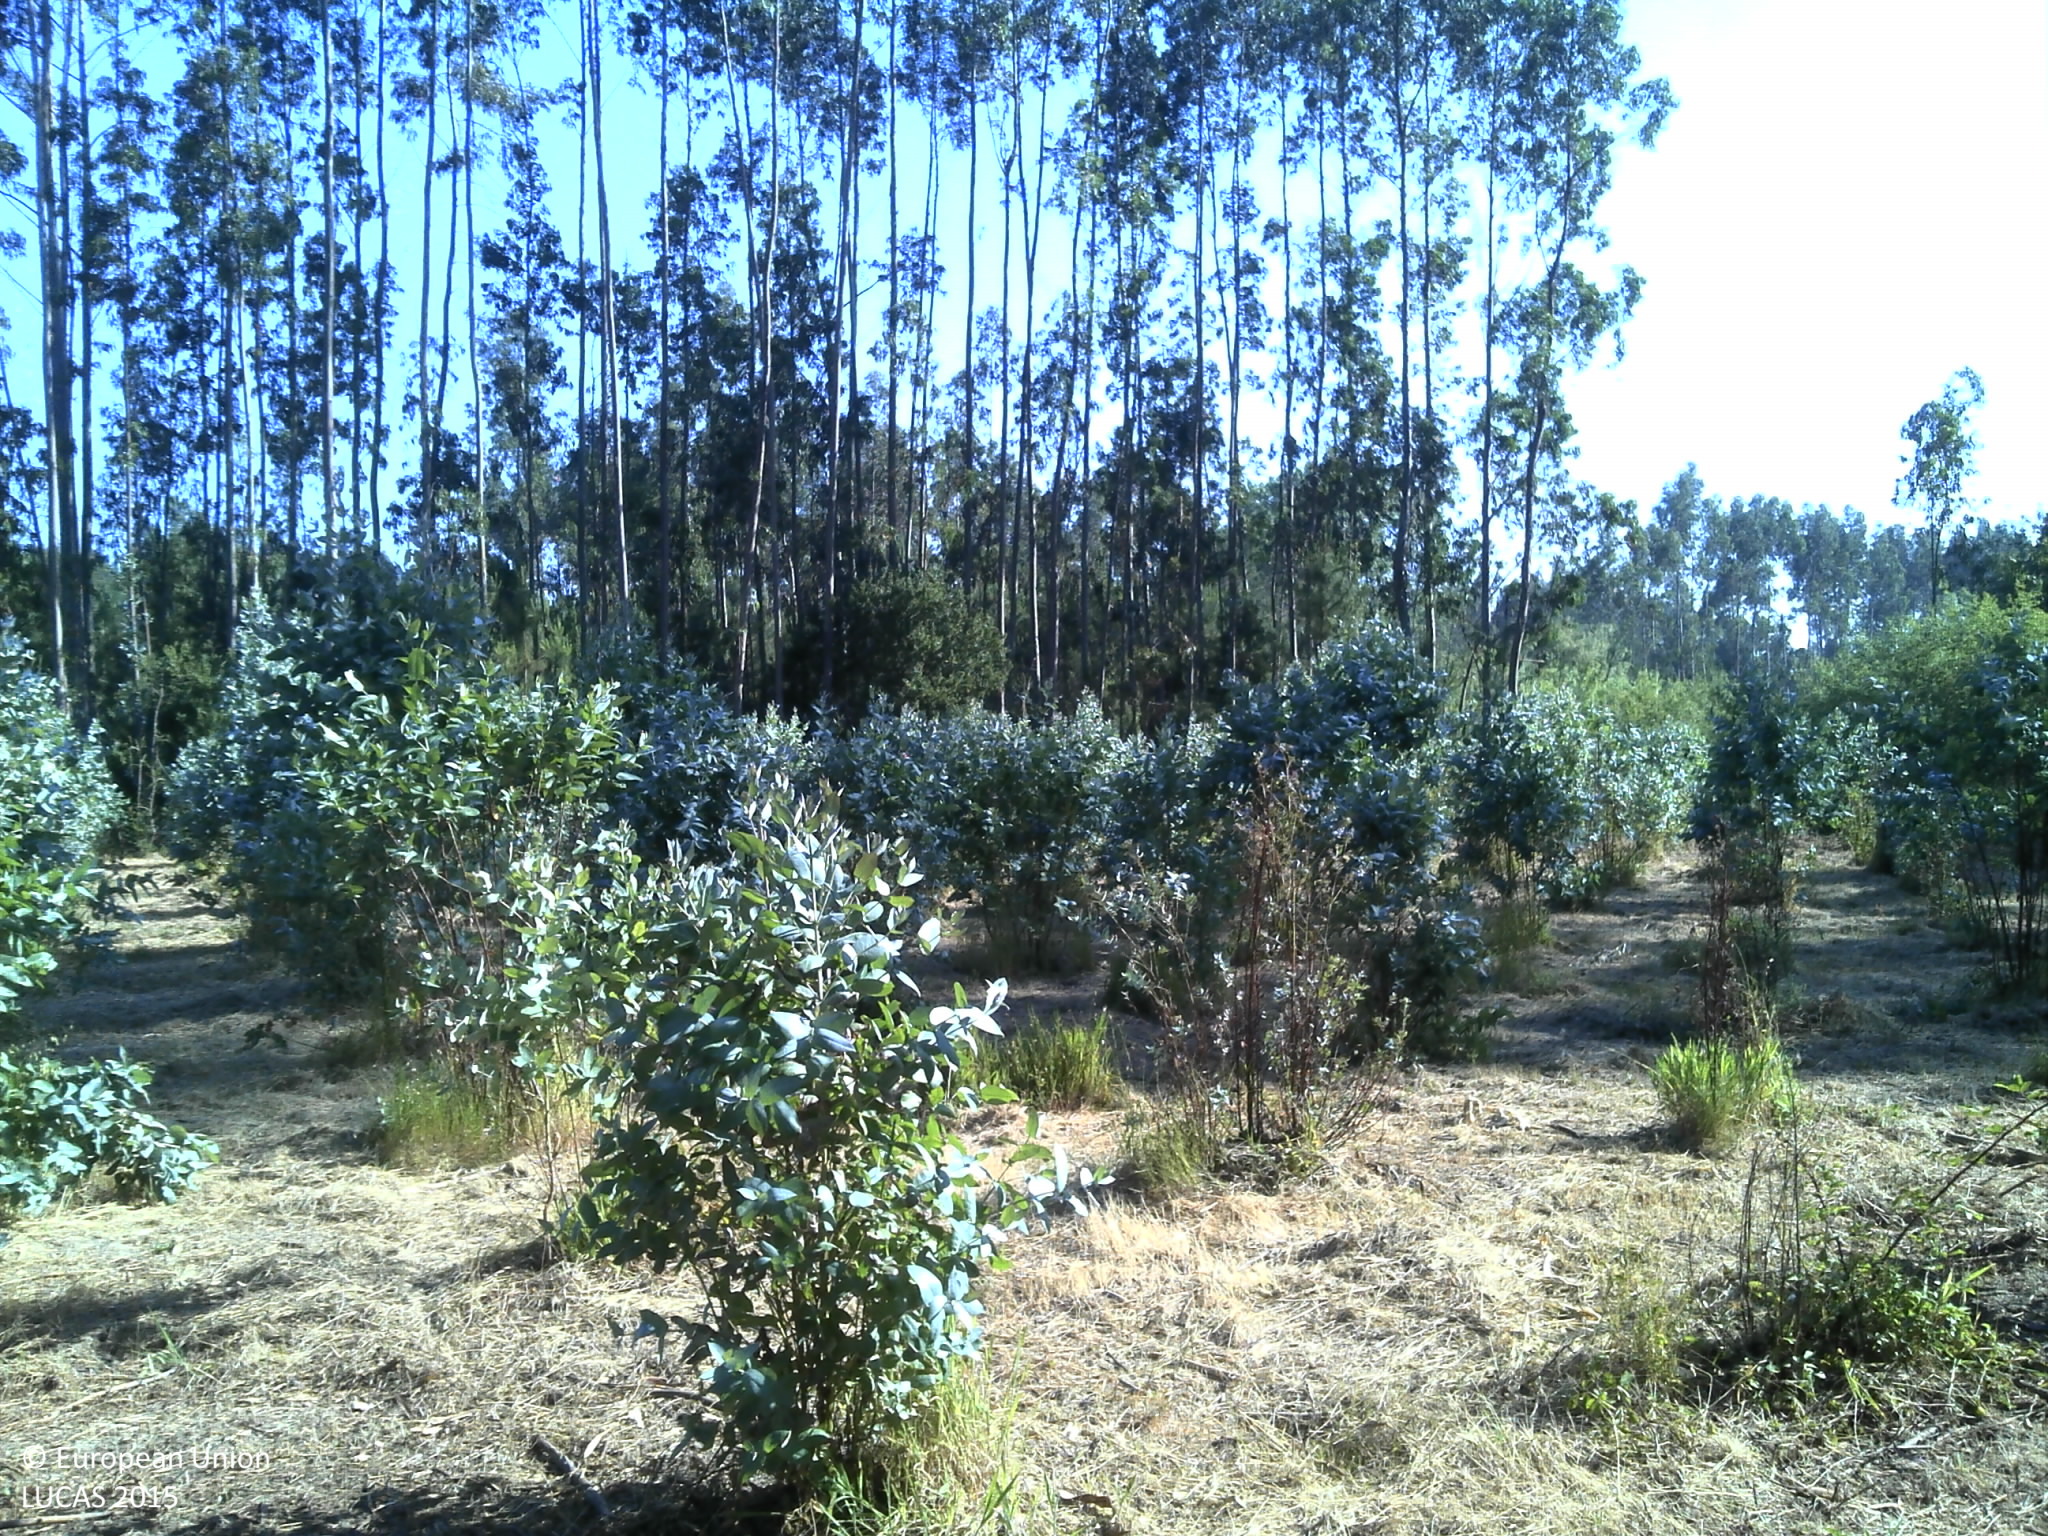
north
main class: Woodland
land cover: Broadleaved woodland
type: exotic forest
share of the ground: 25 - 50 %
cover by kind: unconsolidated bare surface 55 %, broadleaved forest trees 30 %, shrubs 10 %, herbaceous plants 5 %
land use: Forestry
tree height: < 5 m
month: May
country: PT
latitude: 40.4038
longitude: -8.6516
